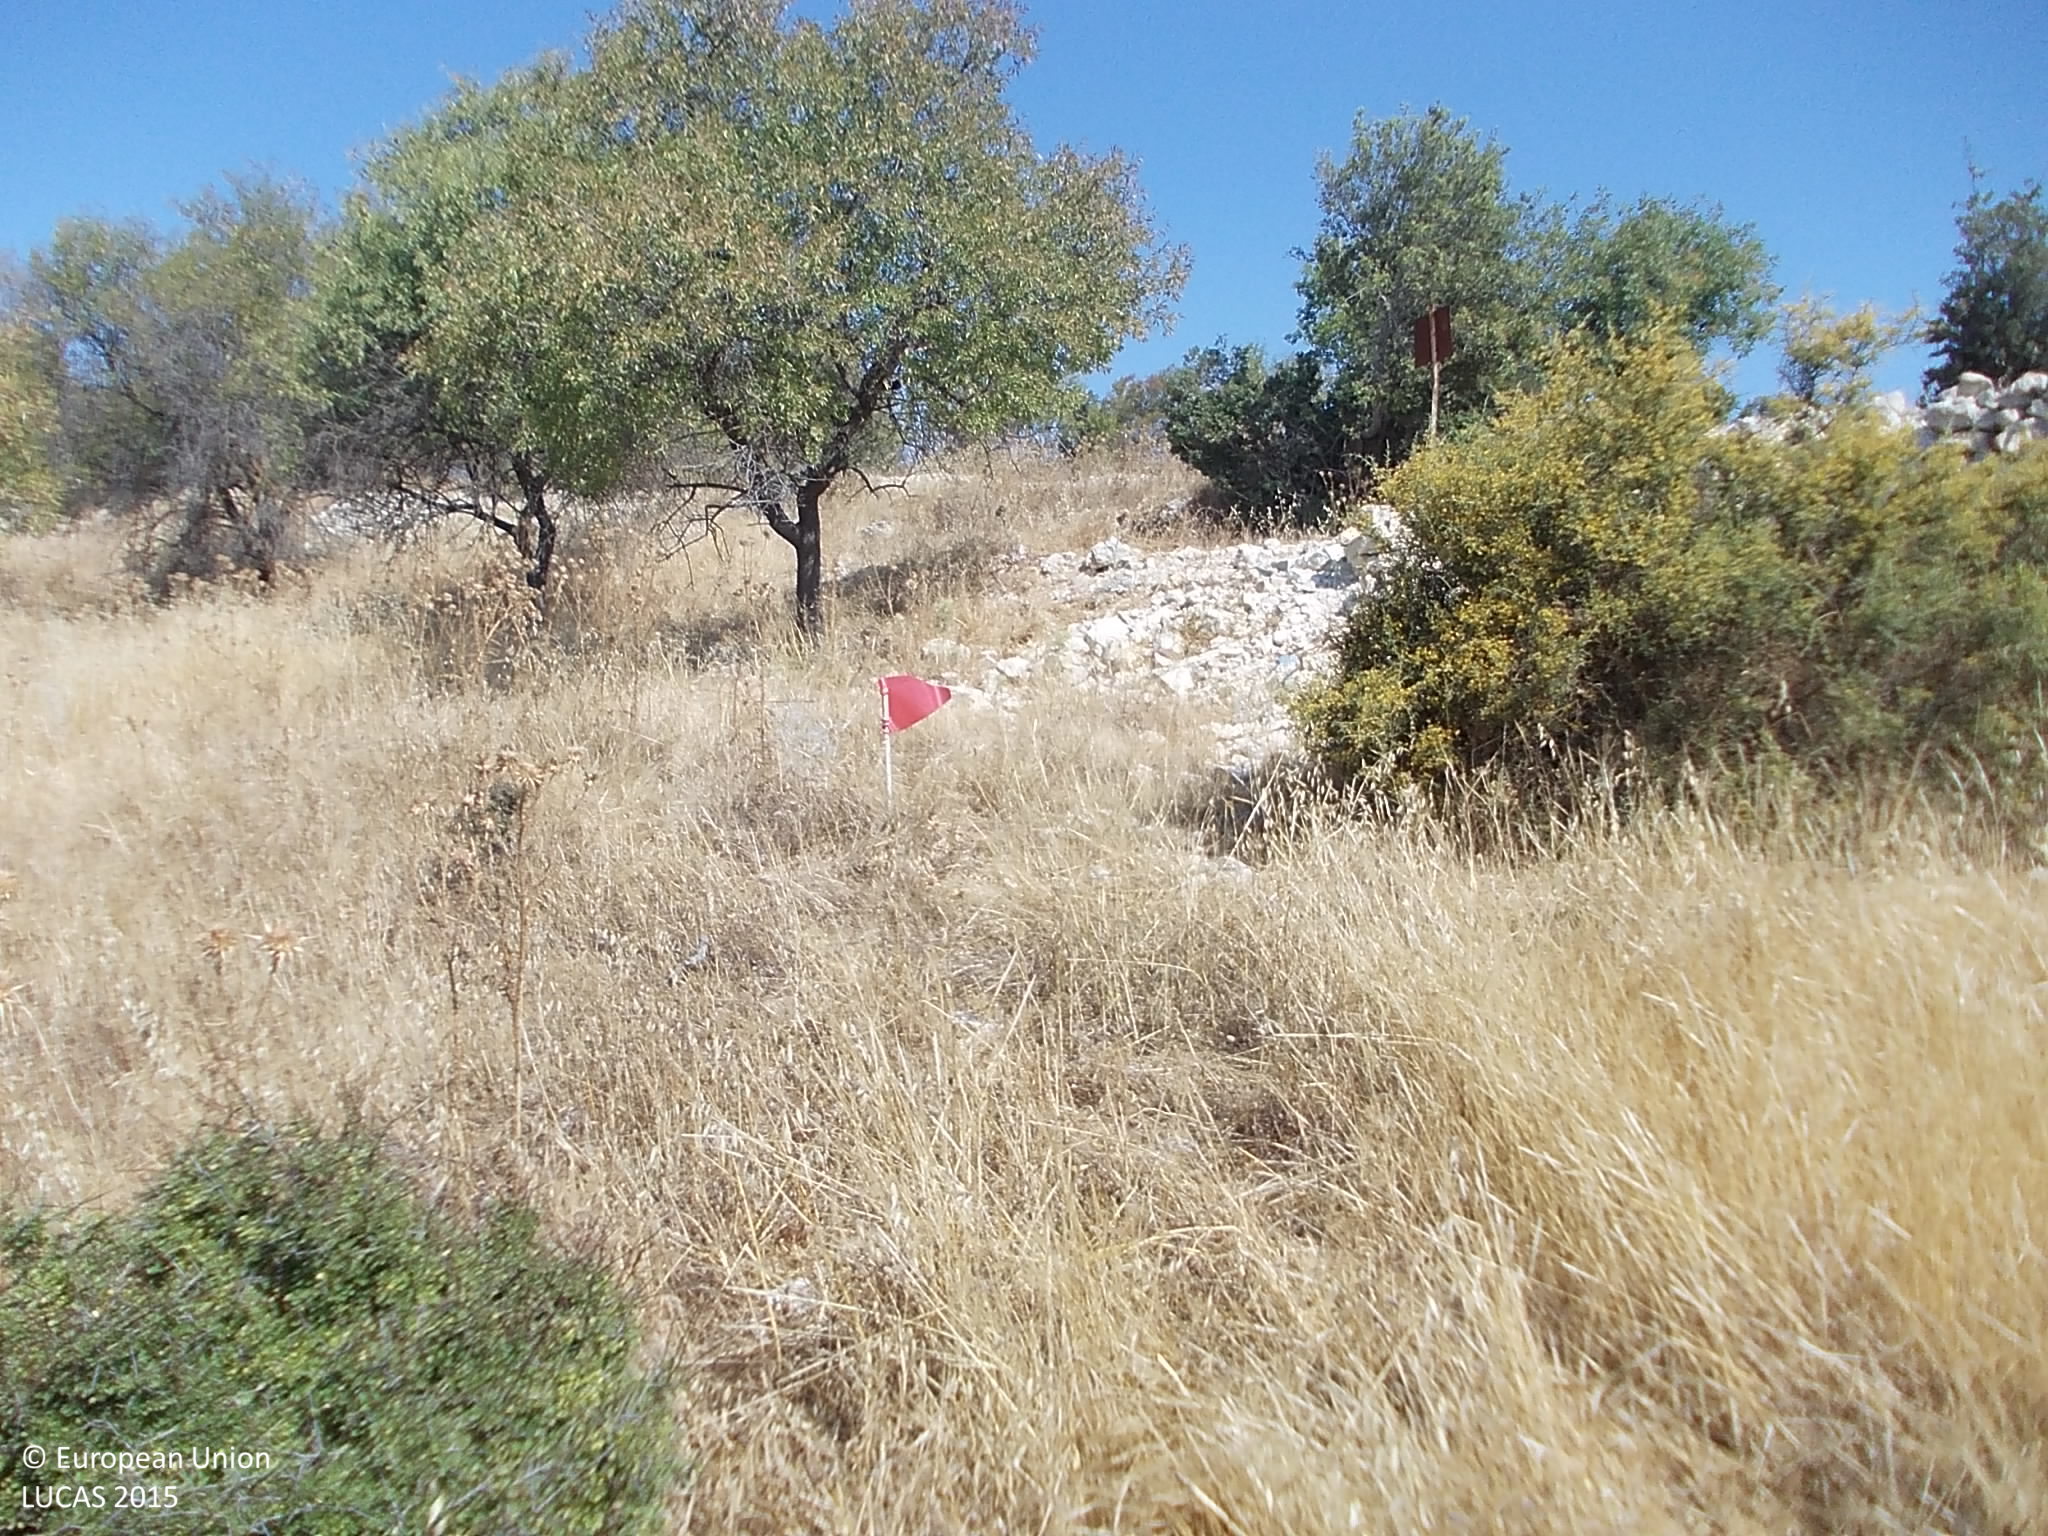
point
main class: Cropland
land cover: Nuts trees
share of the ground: 10 - 25 %
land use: Agriculture (excluding fallow land and kitchen gardens)
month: July
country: CY
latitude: 34.7838
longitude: 32.7452
